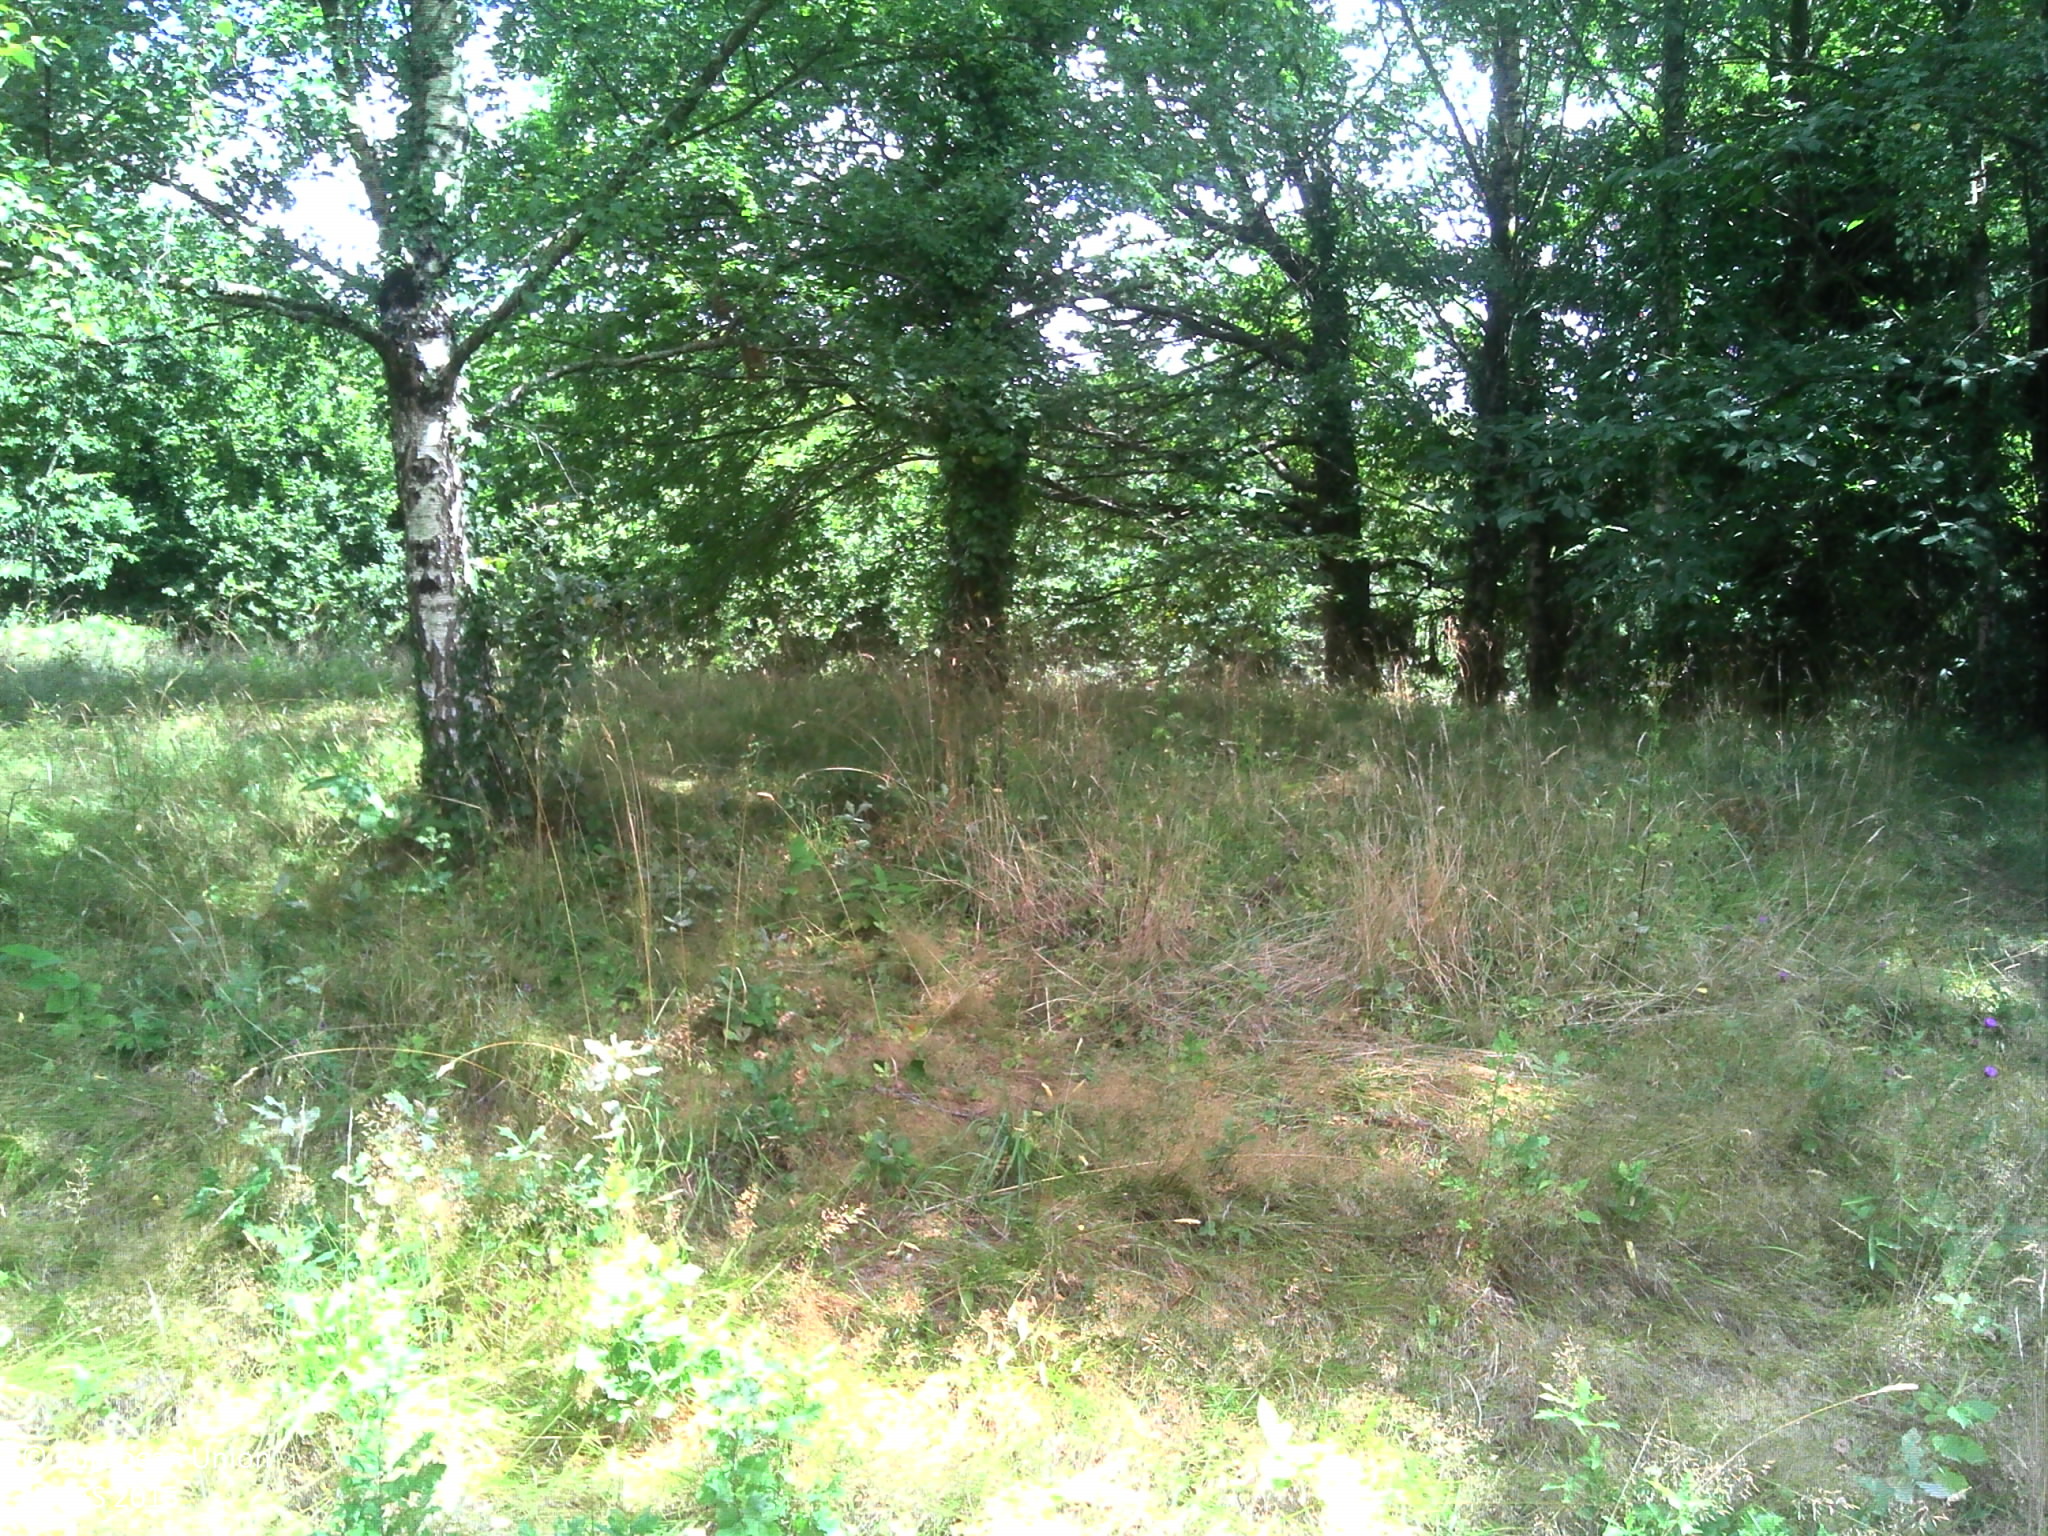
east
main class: Grassland
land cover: Grassland with sparse tree/shrub cover
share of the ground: > 75 %
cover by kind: herbaceous plants 85 %, shrubs 10 %, broadleaved forest trees 5 %
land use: Residential
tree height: > 5 m
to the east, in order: Grassland with sparse tree/shrub cover; Broadleaved woodland; Fences; Grassland without tree/shrub cover; Ditches and canals; Broadleaved woodland; Shrubland with sparse tree cover; Electric lines; Broadleaved woodland; Fences; Broadleaved woodland; Grassland without tree/shrub cover; Fences; Ditches and canals; Abandoned hedges; Fences; Grassland without tree/shrub cover; Fences; Abandoned hedges; Fences; Grassland without tree/shrub cover
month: August
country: FR
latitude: 46.7233
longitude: -1.3812
